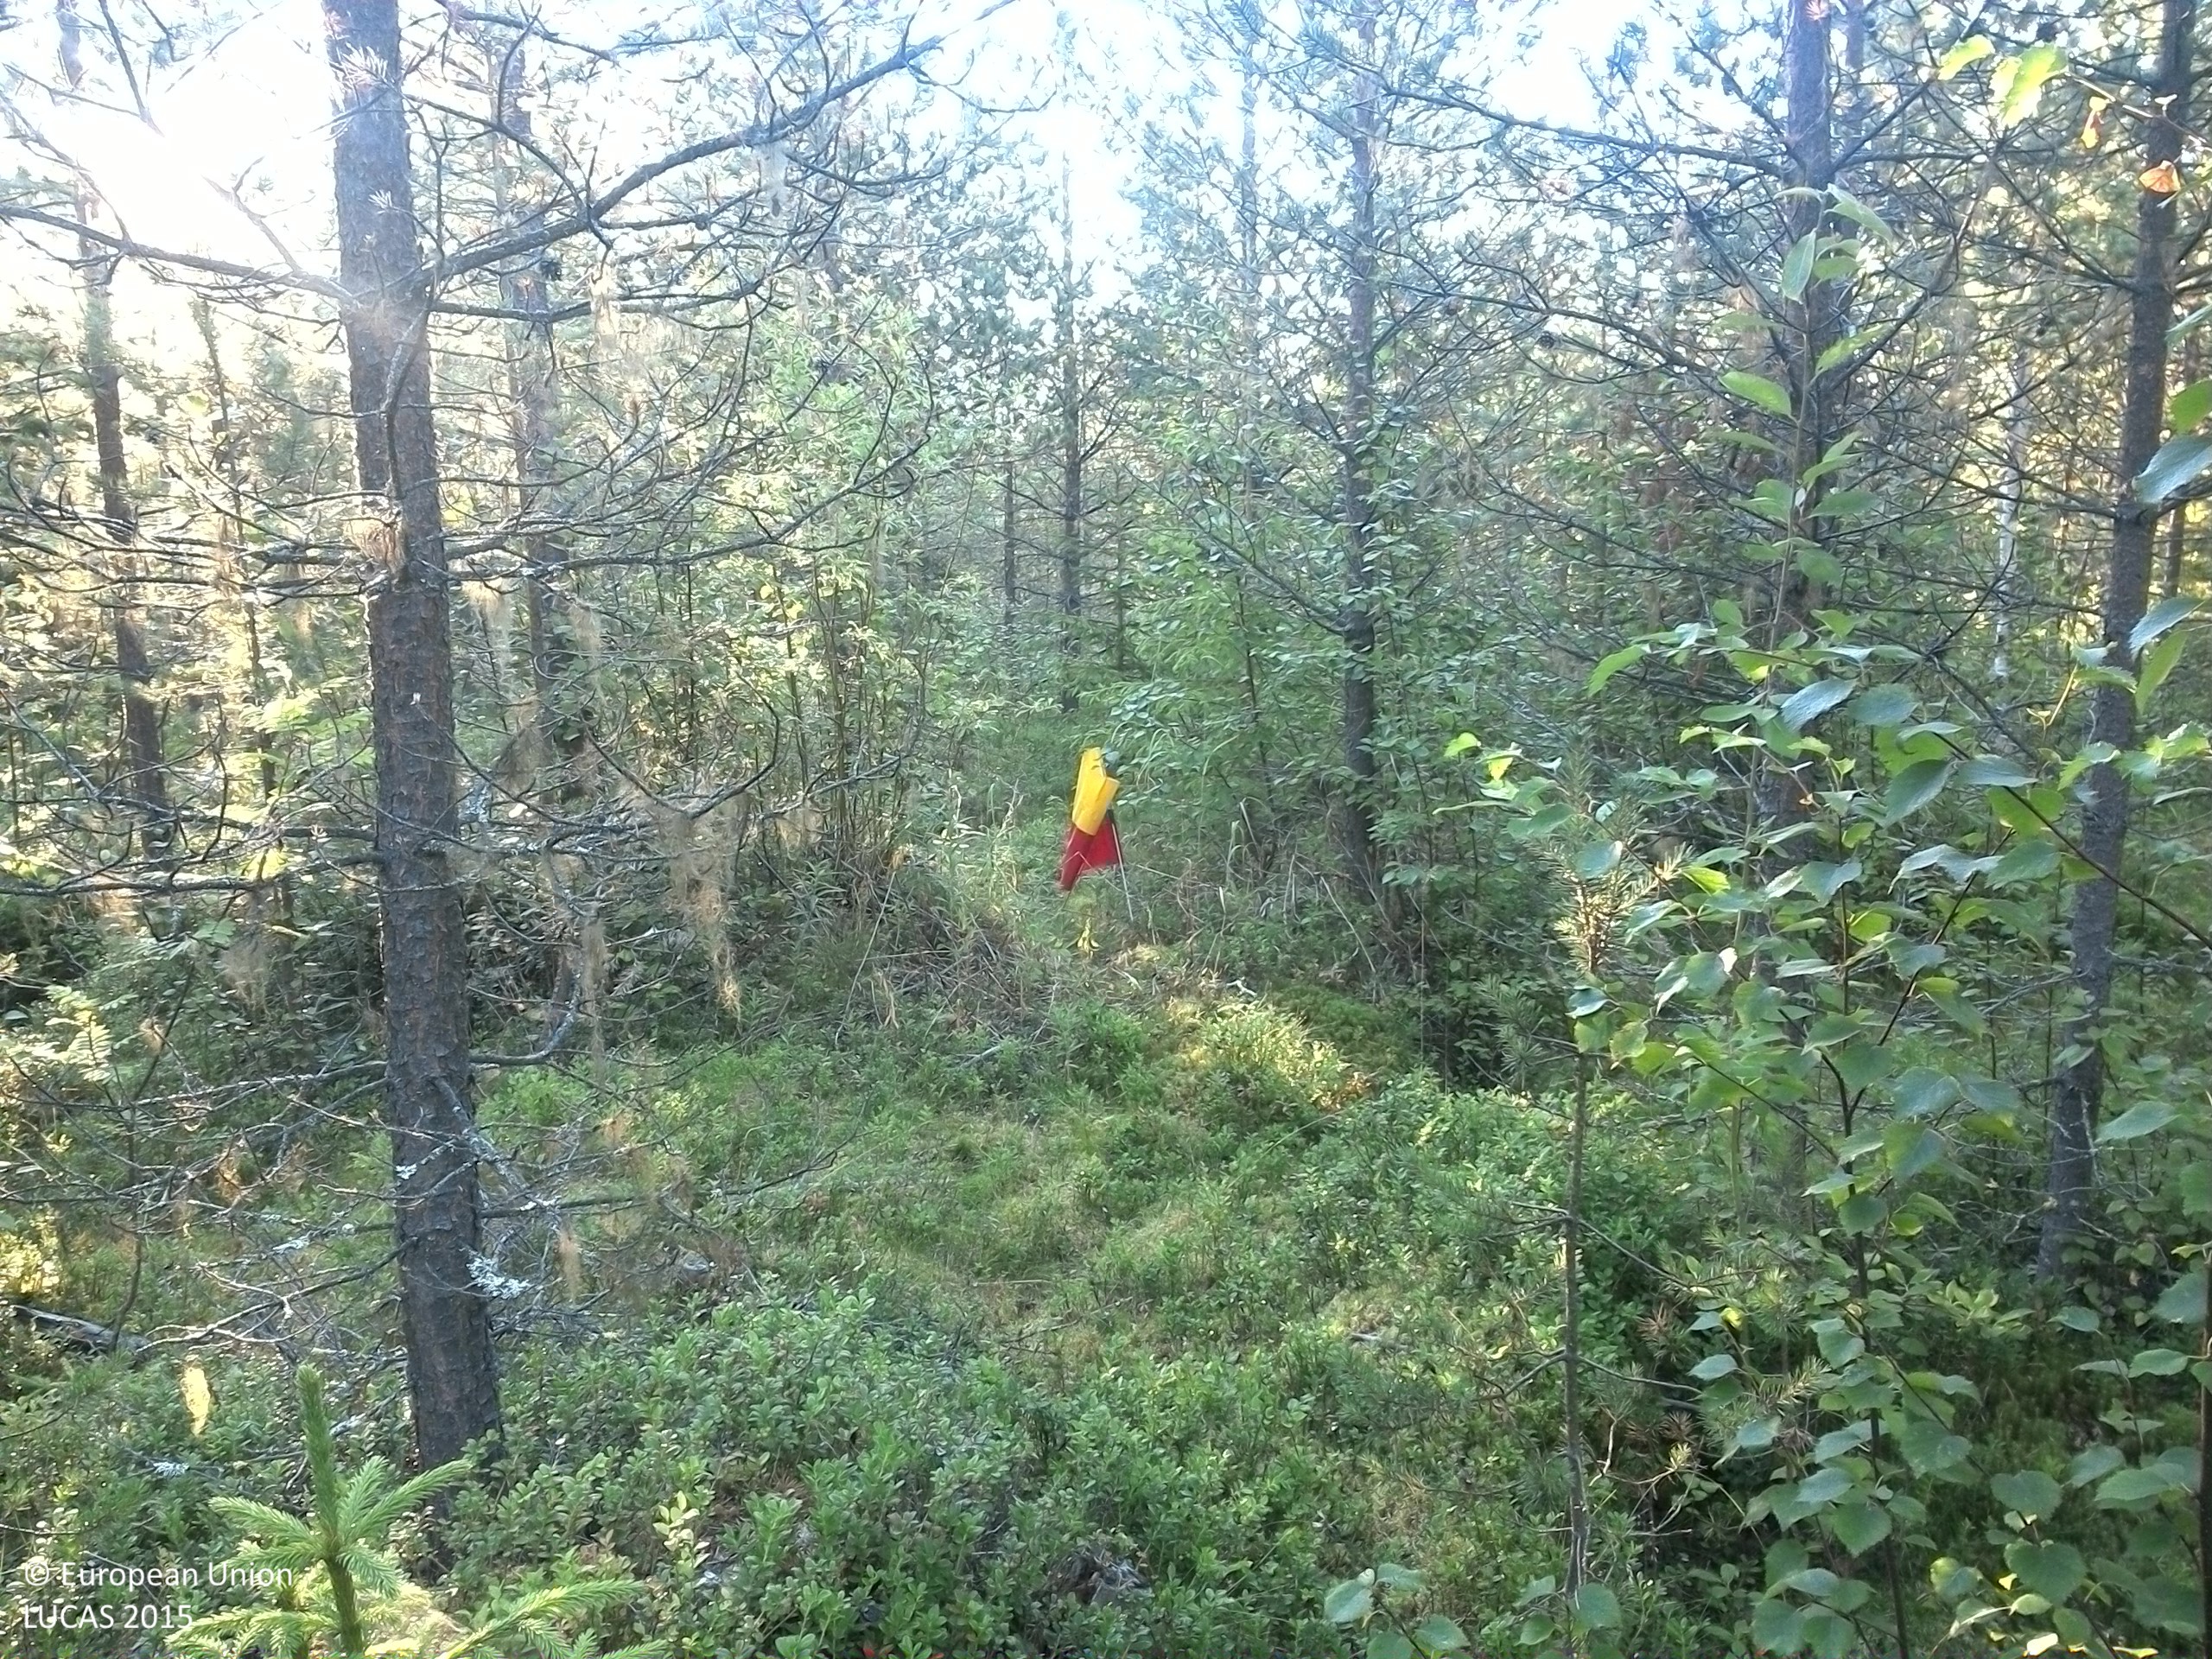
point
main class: Woodland
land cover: Pine dominated coniferous woodland
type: boreal forest
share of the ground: 25 - 50 %
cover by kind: shrubs 40 %, coniferous forest trees 35 %, lichens and mosses 15 %, broadleaved forest trees 5 %, herbaceous plants 5 %
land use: Forestry
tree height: > 5 m
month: August
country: SE
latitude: 64.1141
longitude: 16.6422
